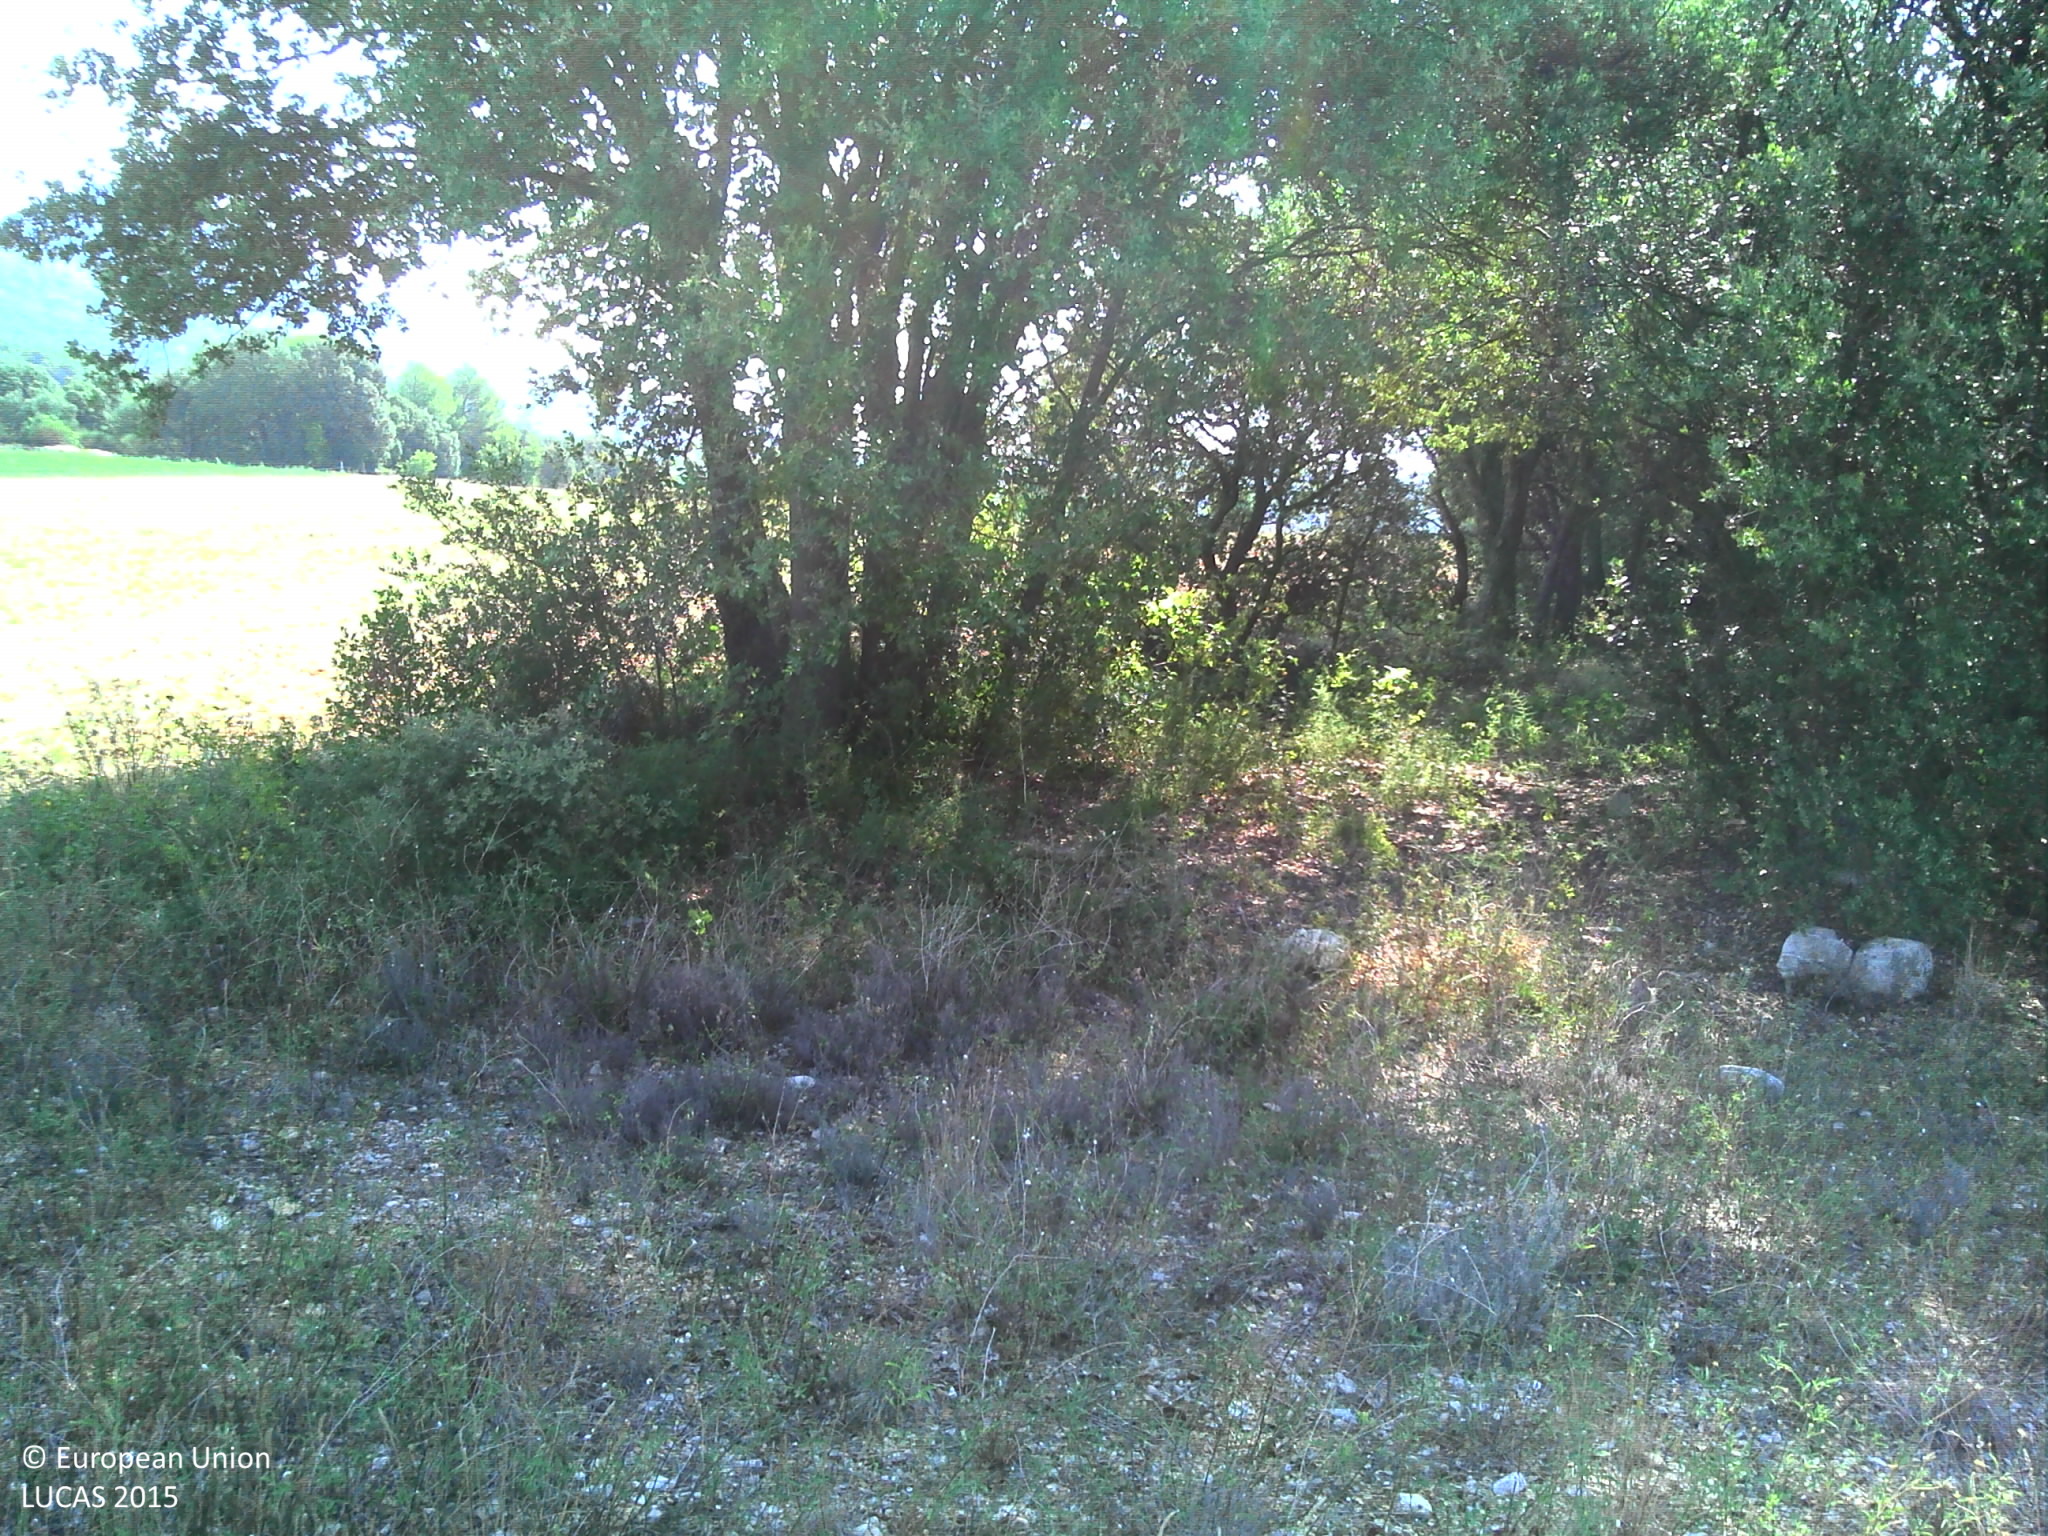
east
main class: Cropland
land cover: Permanent industrial crops
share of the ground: 25 - 50 %
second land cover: Other bare soil
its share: > 75 %
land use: Abandoned areas
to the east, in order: Permanent industrial crops; Other bare soil; Spontaneously vegetated surfaces; Broadleaved woodland; Other bare soil; Single bushes/trees; Barley; Tracks; Spontaneously vegetated surfaces
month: August
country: FR
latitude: 43.9262
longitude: 5.4623
